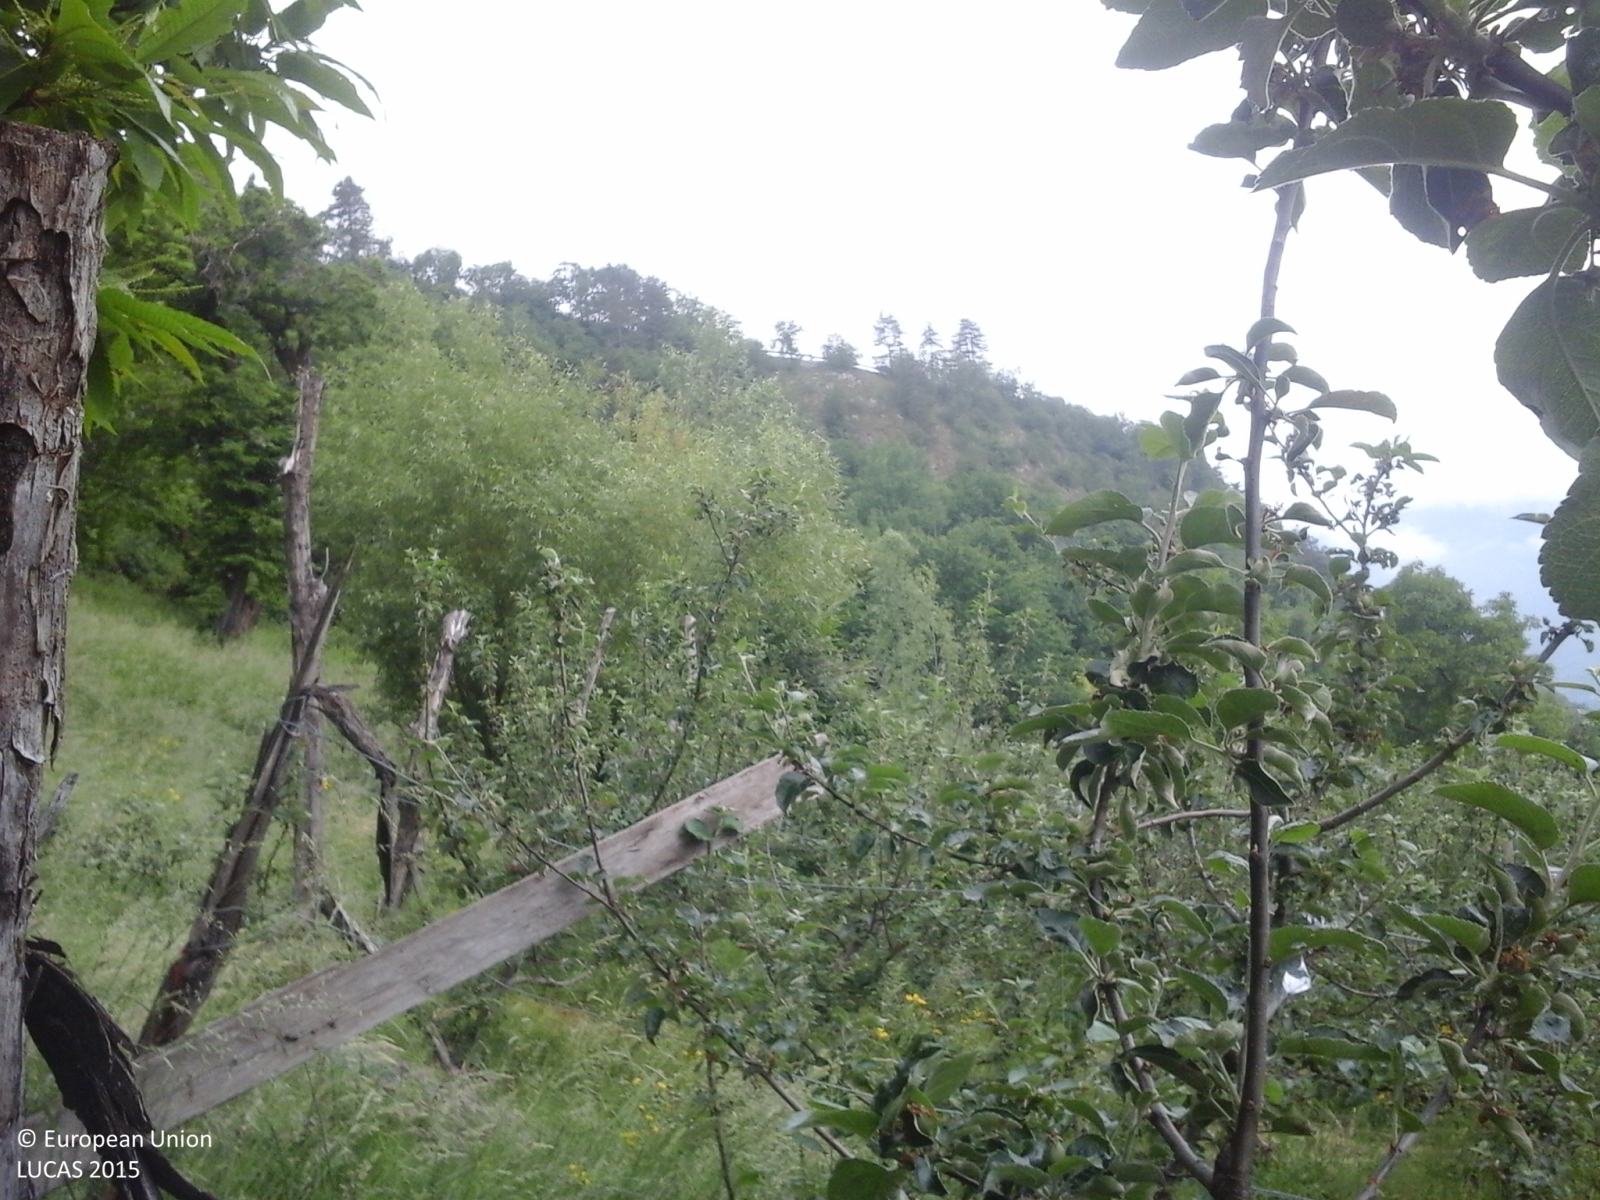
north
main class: Cropland
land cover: Apple fruit
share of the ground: 25 - 50 %
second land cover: Grassland without tree/shrub cover
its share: > 75 %
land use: Agriculture (excluding fallow land and kitchen gardens)
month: May
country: IT
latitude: 45.8244
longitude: 10.9639
